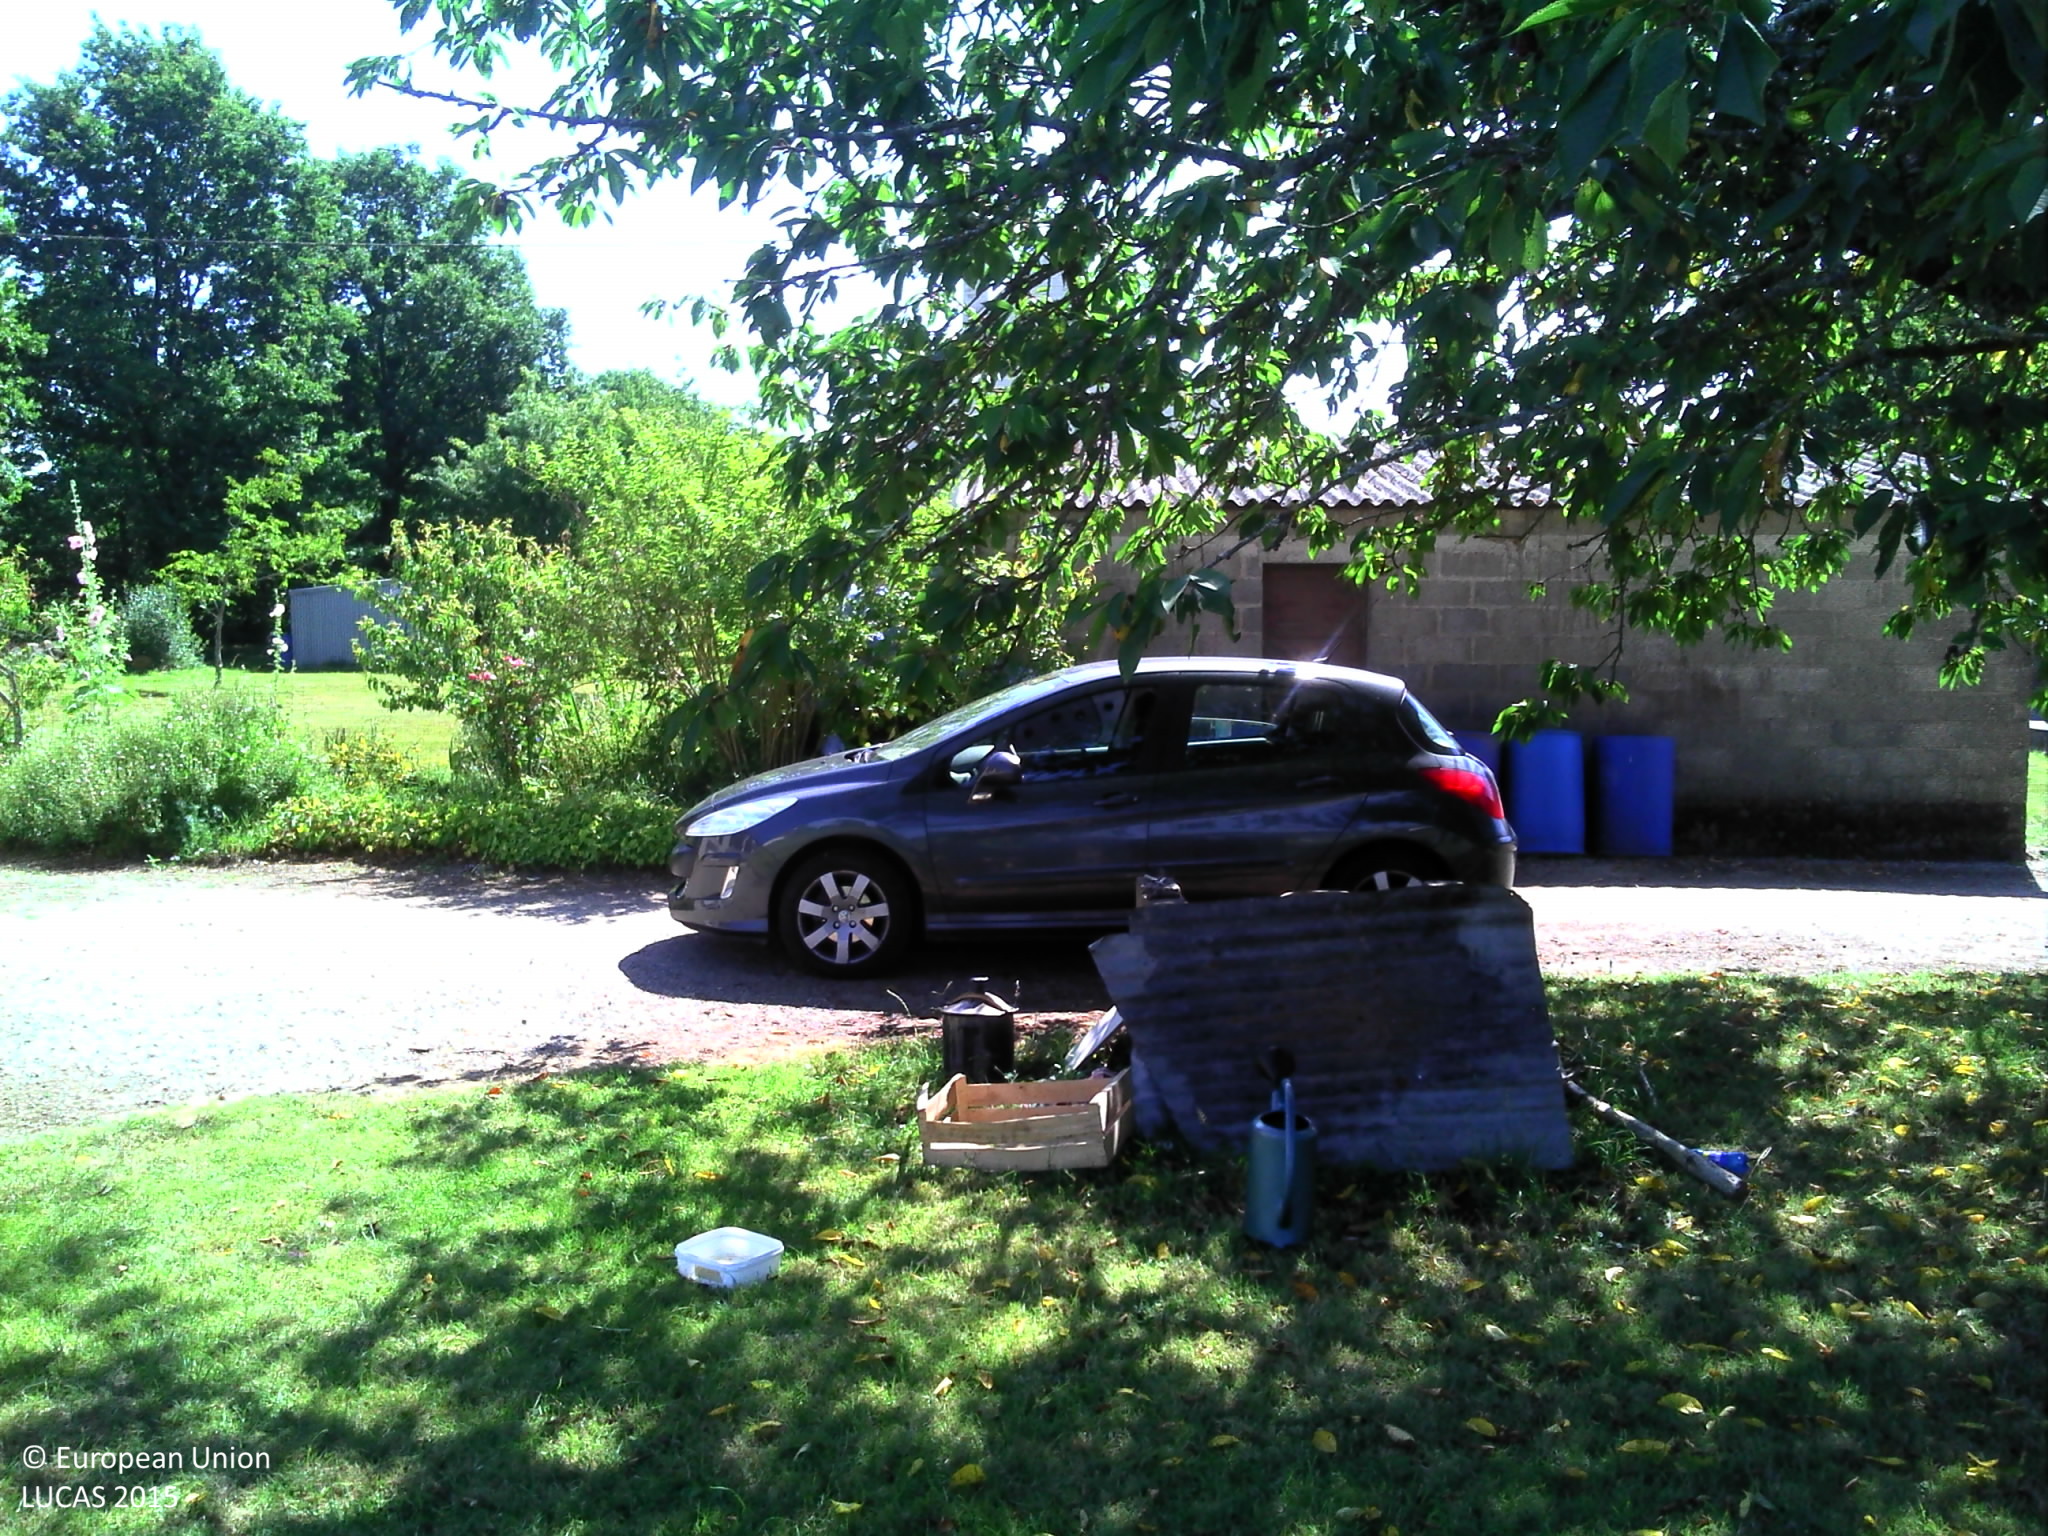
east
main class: Grassland
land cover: Grassland with sparse tree/shrub cover
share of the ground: > 75 %
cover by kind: herbaceous plants 95 %, broadleaved forest trees 5 %
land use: Residential
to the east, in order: Grassland with sparse tree/shrub cover; Artificial constructions in urban areas; Grassland with sparse tree/shrub cover; Electric lines; Shrubland with sparse tree cover; Grassland with sparse tree/shrub cover; Shrubland with sparse tree cover; Ditches and canals; Grass margins; Tracks; Grass margins; Ditches and canals; Common wheat; Electric lines; Common wheat
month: July
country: FR
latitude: 47.6305
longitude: -2.0685
